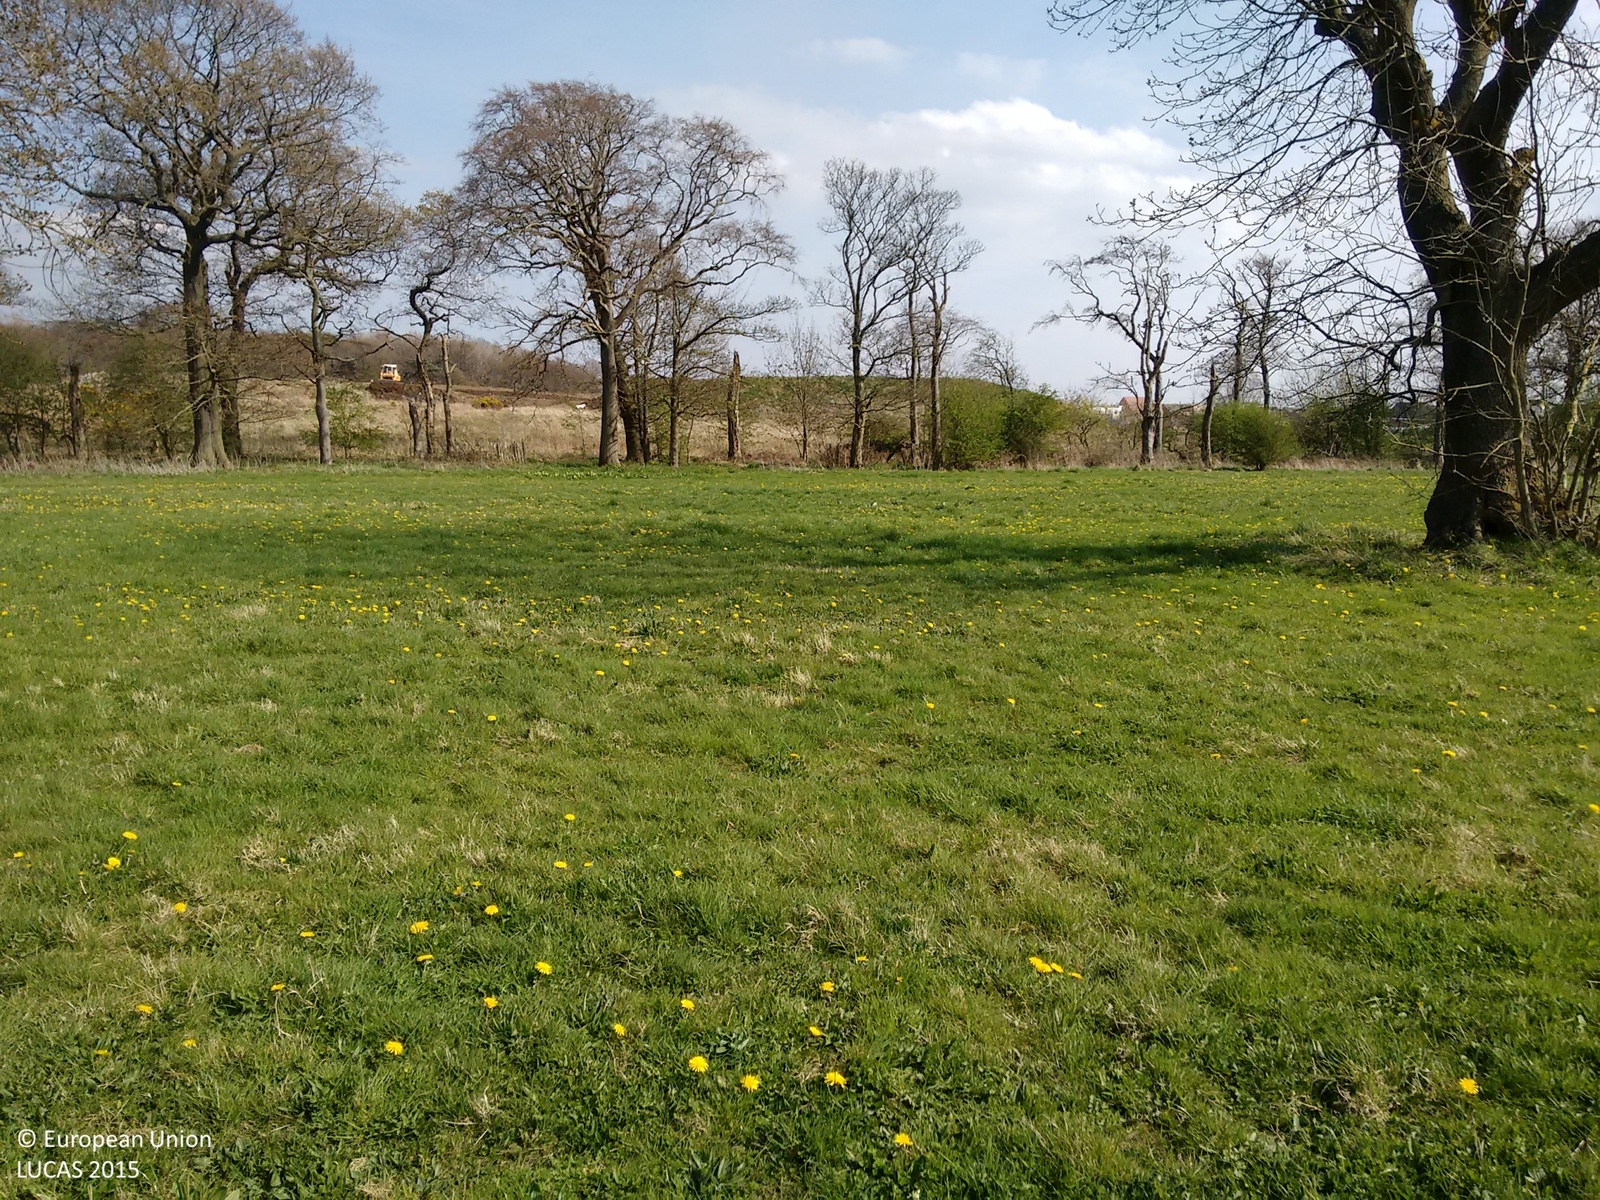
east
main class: Grassland
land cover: Grassland with sparse tree/shrub cover
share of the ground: > 75 %
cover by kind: herbaceous plants 95 %, broadleaved forest trees 5 %
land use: Agriculture (excluding fallow land and kitchen gardens)
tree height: > 5 m
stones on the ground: < 10 %
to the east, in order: Grassland with sparse tree/shrub cover; Groves; Rivers and streams; Groves; Grassland without tree/shrub cover; Artificial constructions
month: April
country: GB
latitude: 55.0373
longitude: -1.6440
